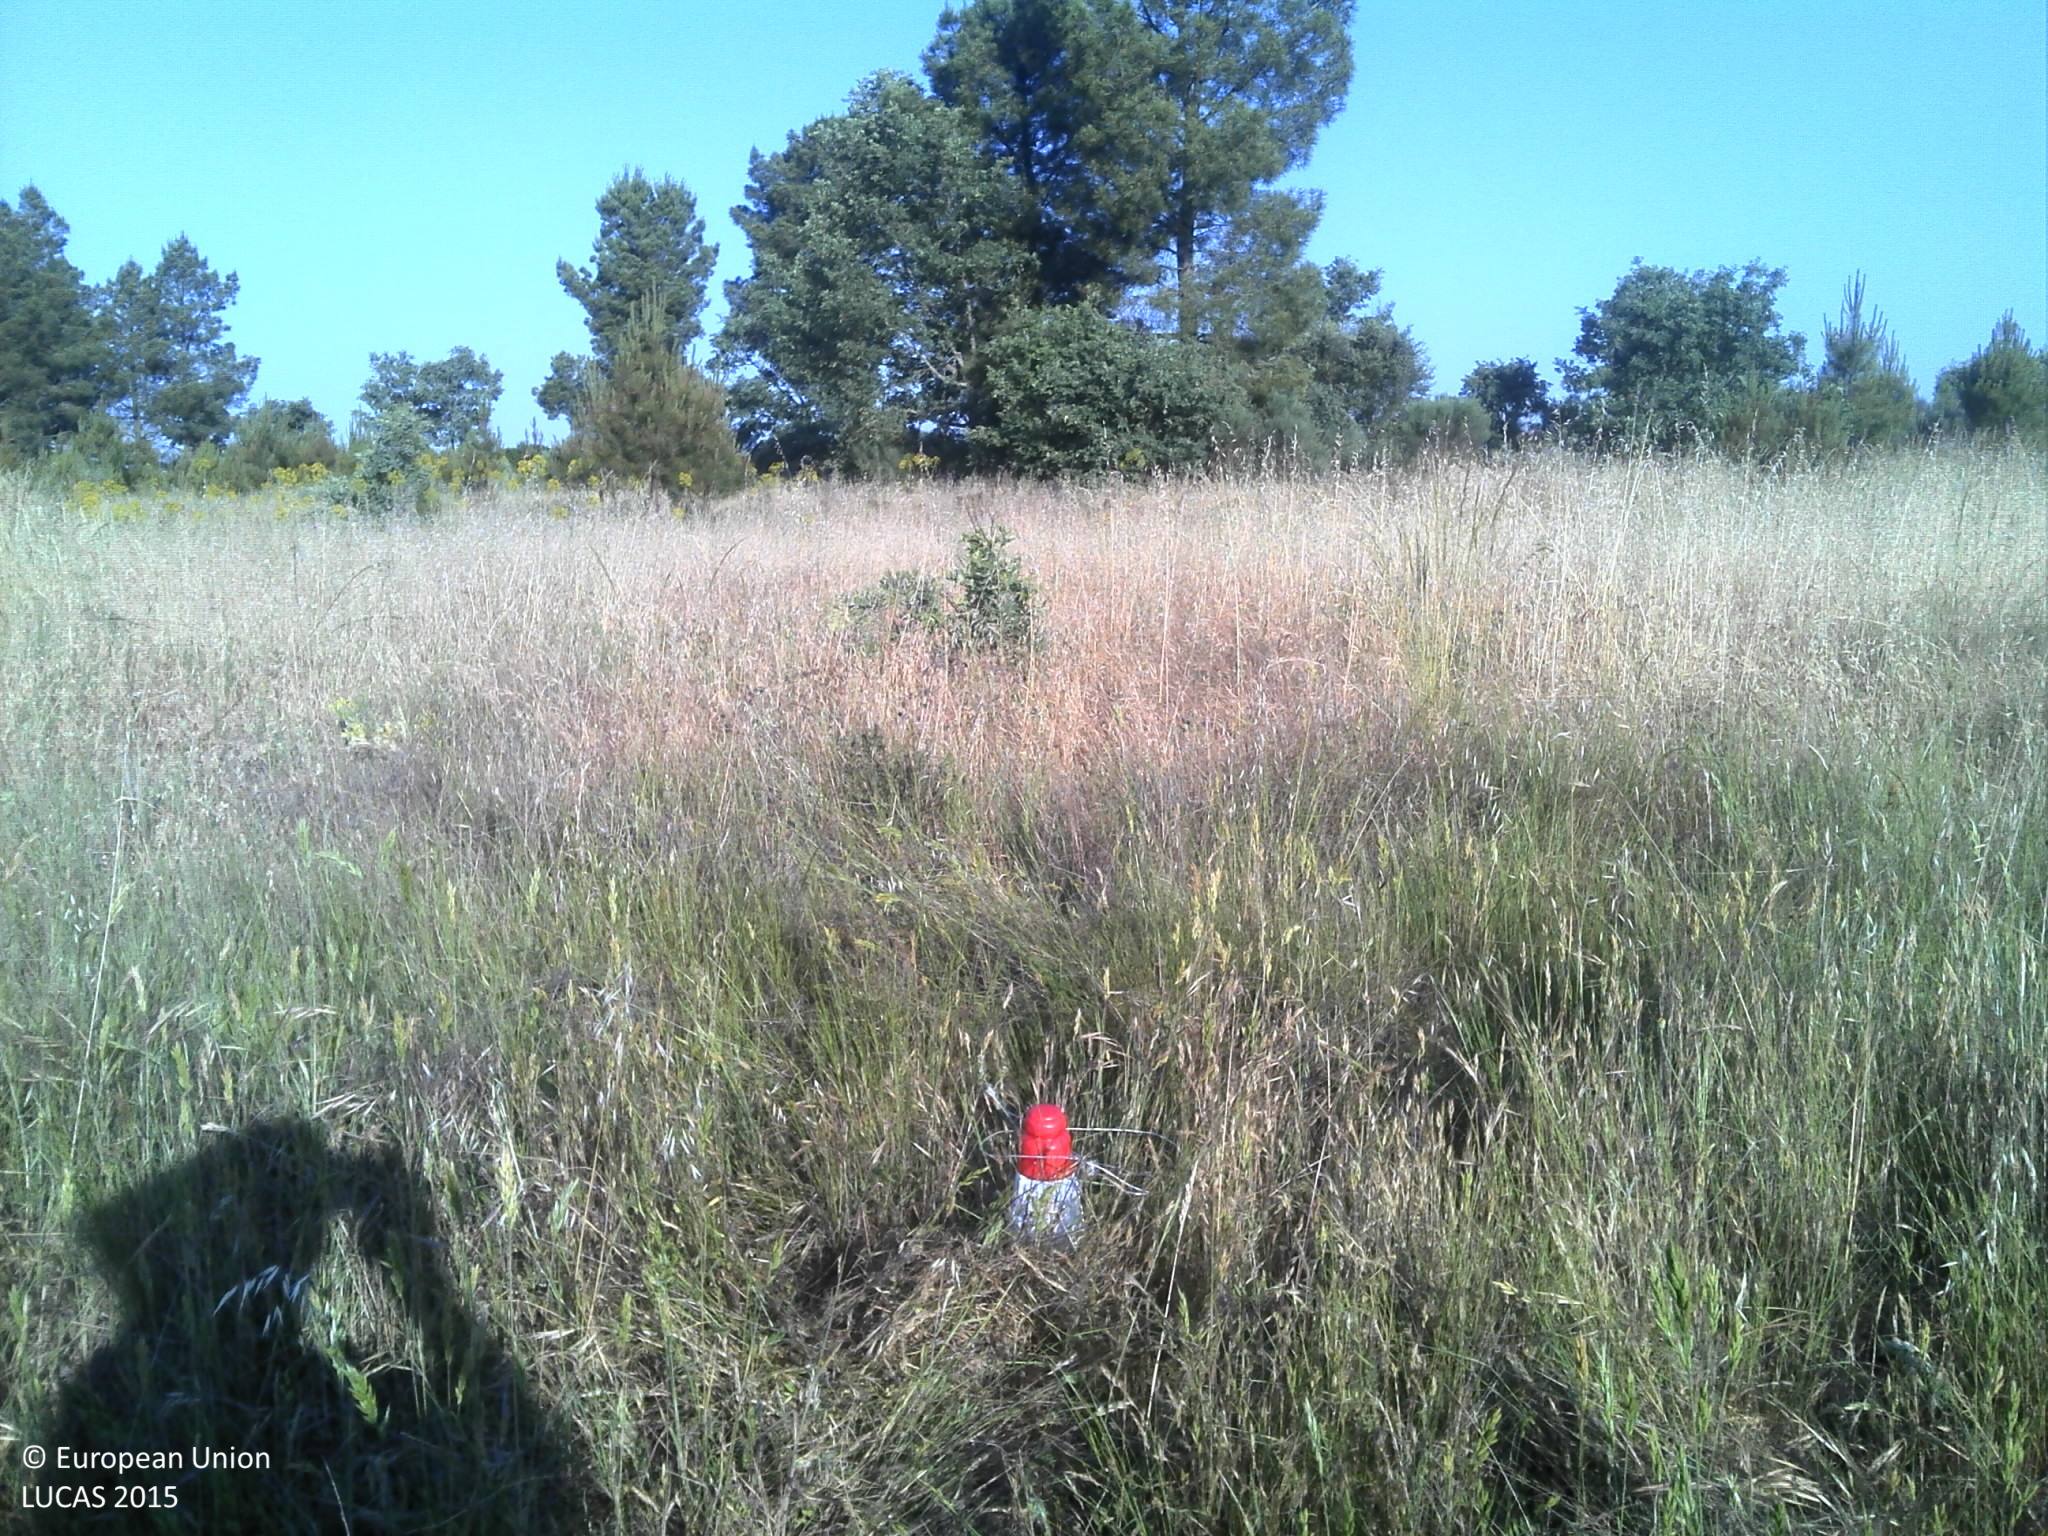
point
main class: Grassland
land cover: Grassland without tree/shrub cover
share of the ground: 50 - 75 %
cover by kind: herbaceous plants 70 %, unconsolidated bare surface 20 %
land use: Agriculture (excluding fallow land and kitchen gardens)
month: June
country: PT
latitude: 40.5637
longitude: -6.9772
